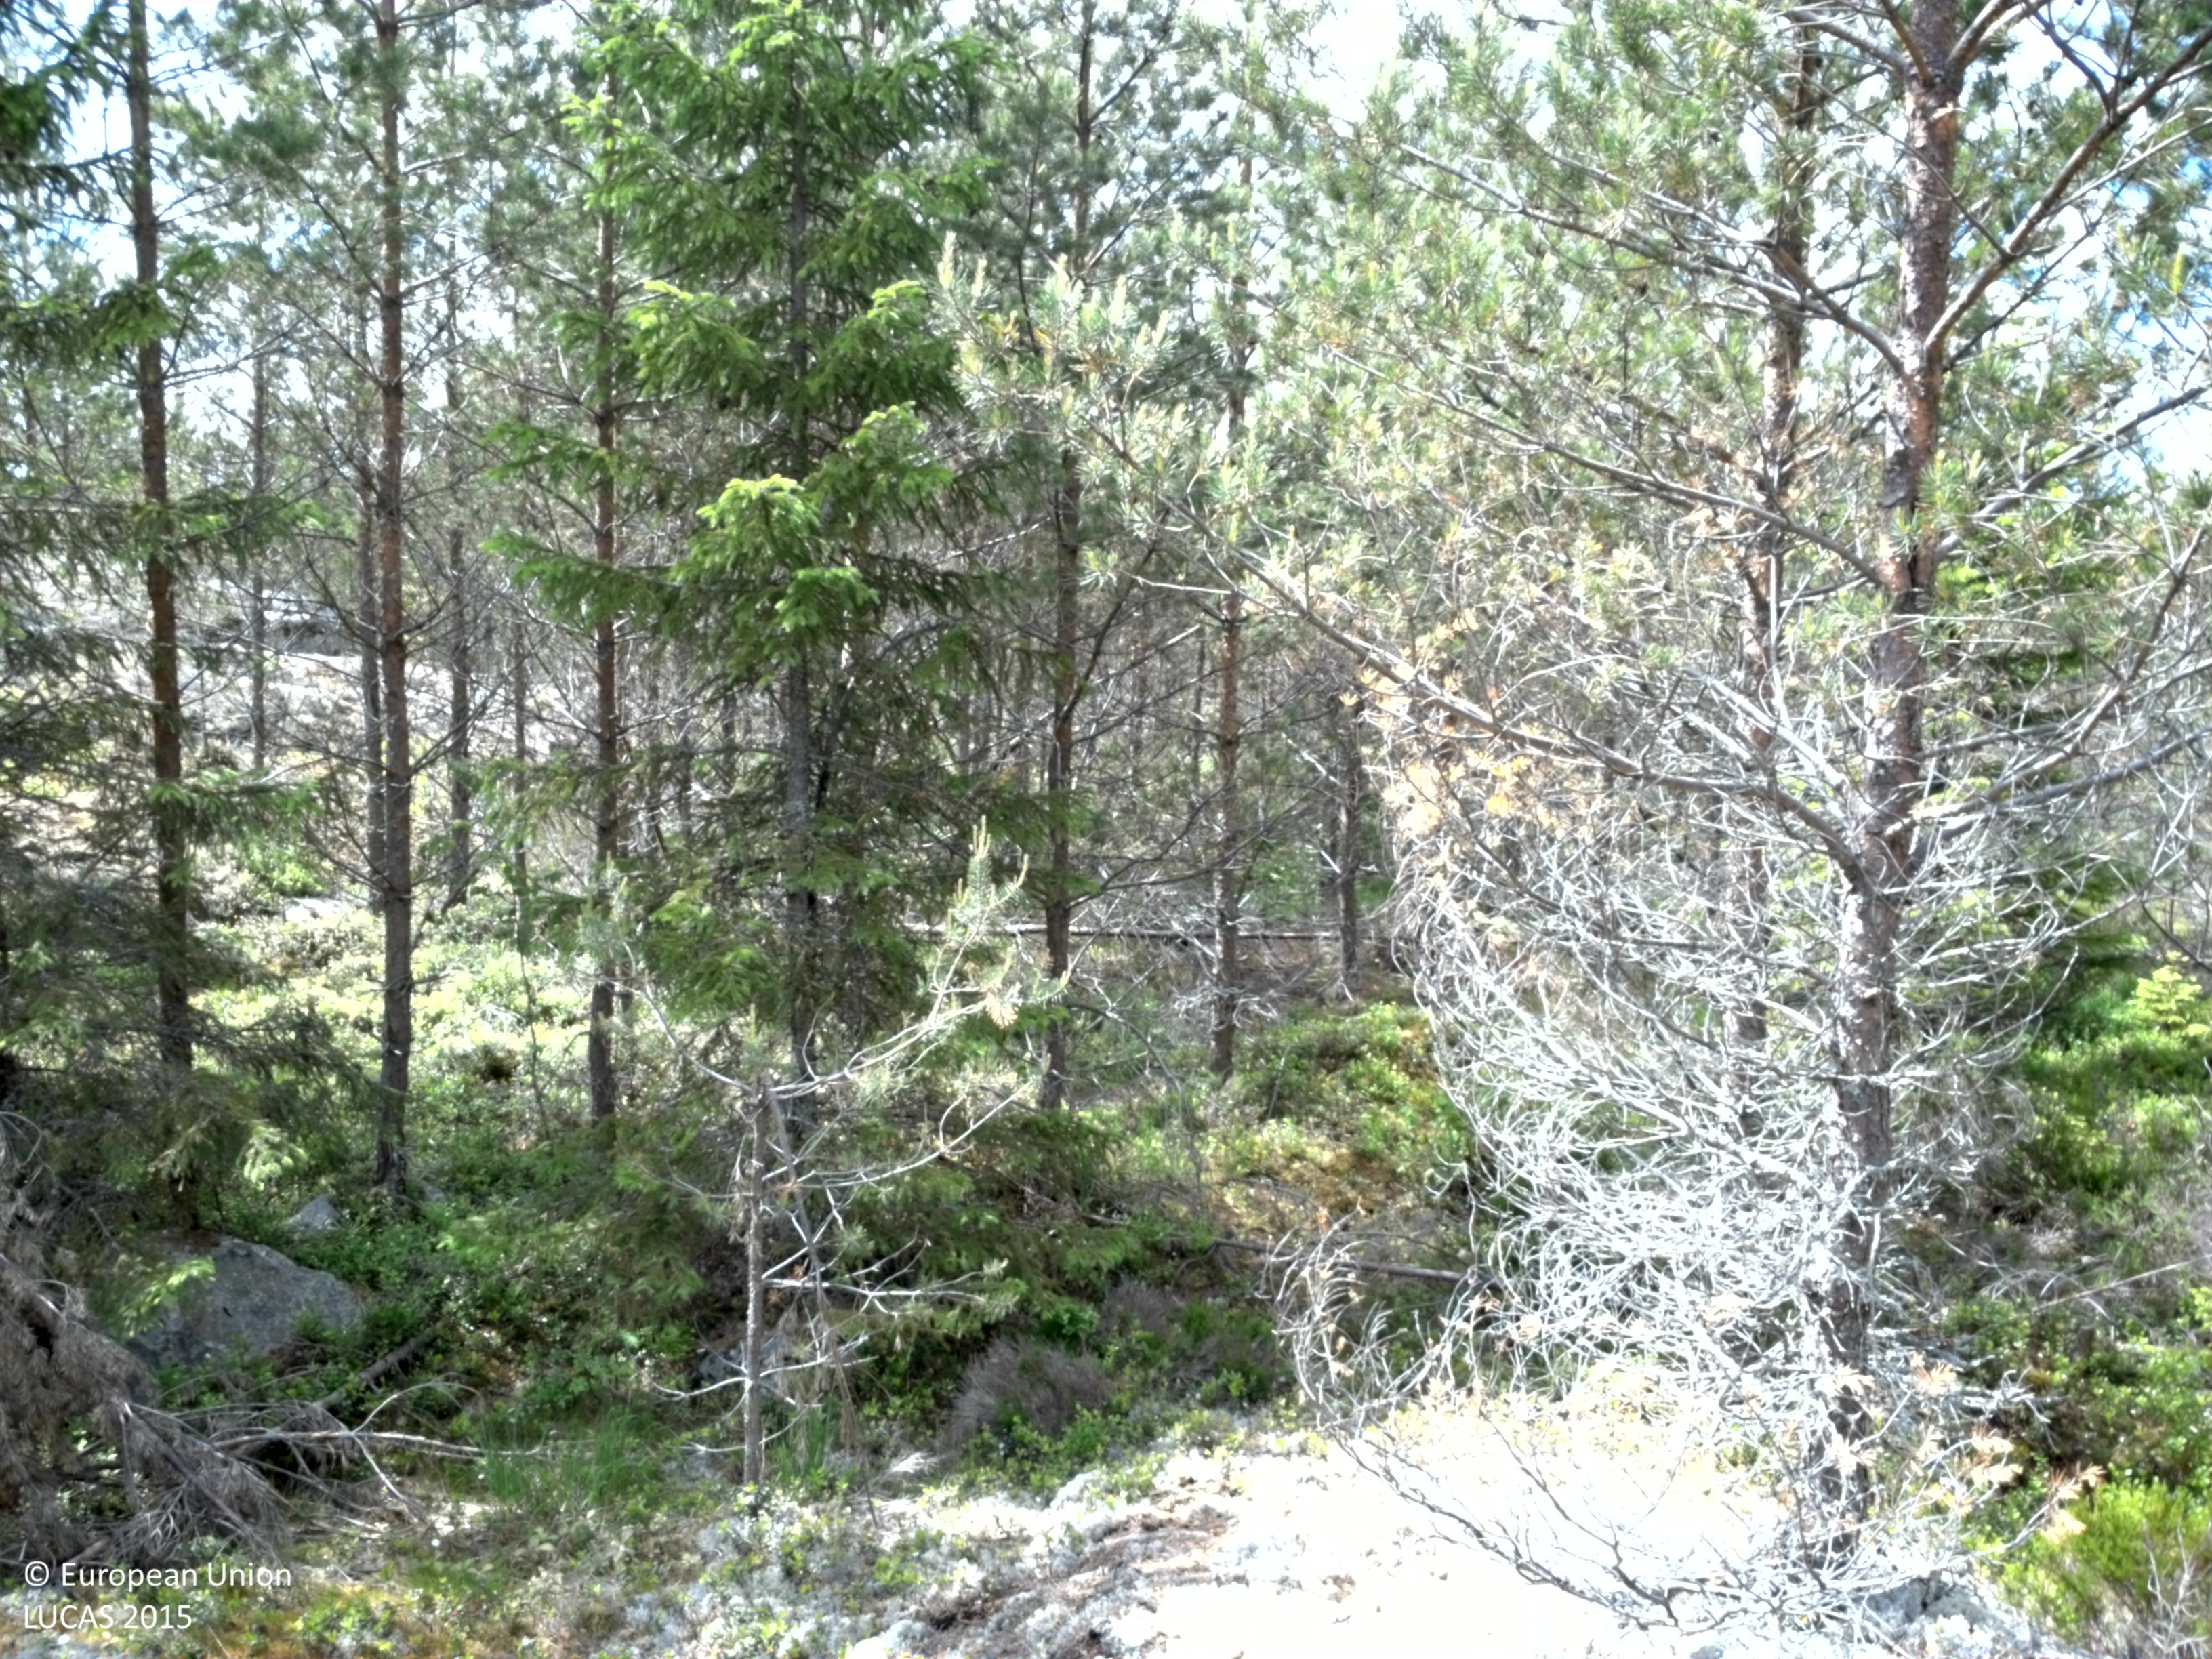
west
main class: Woodland
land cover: Pine dominated coniferous woodland
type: boreal forest
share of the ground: 25 - 50 %
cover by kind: coniferous forest trees 45 %, lichens and mosses 25 %, herbaceous plants 15 %, consolidated bare surface 10 %, broadleaved forest trees 5 %
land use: Forestry
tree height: > 5 m
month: June
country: SE
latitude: 59.9852
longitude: 17.0712
